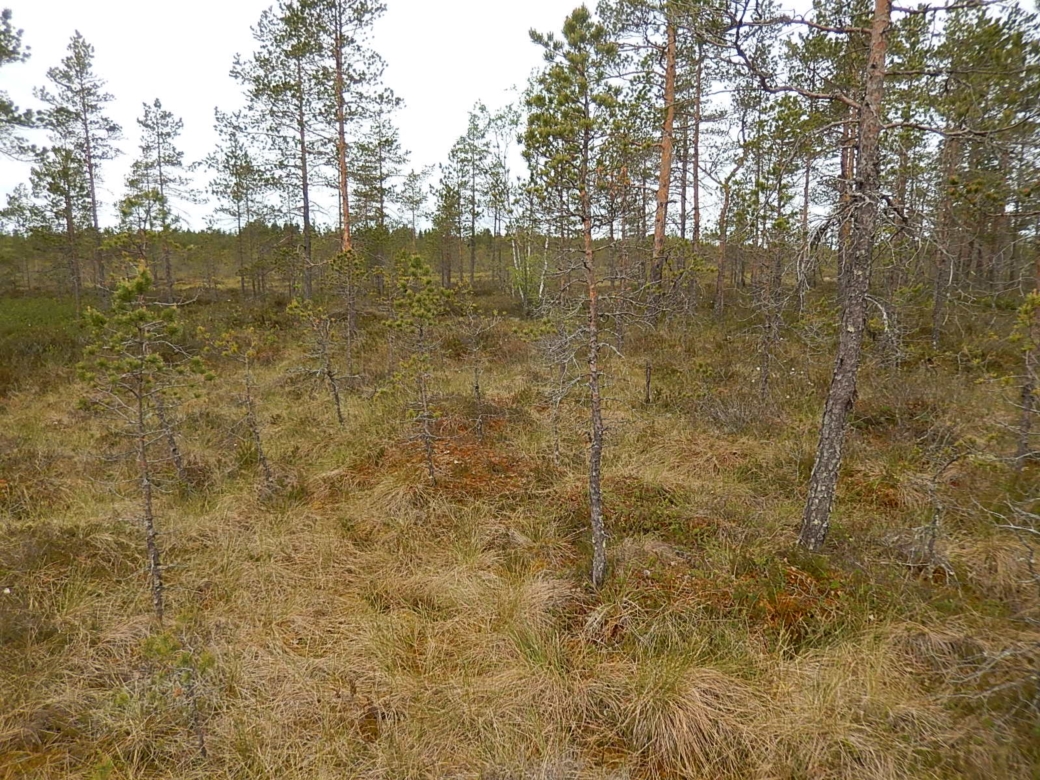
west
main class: Woodland
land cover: Pine dominated coniferous woodland
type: boreal forest
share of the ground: 50 - 75 %
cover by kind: coniferous forest trees 50 %, herbaceous plants 20 %, lichens and mosses 20 %, shrubs 10 %
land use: Forestry
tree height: > 5 m
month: June
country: FI
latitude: 61.9321
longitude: 22.1917
